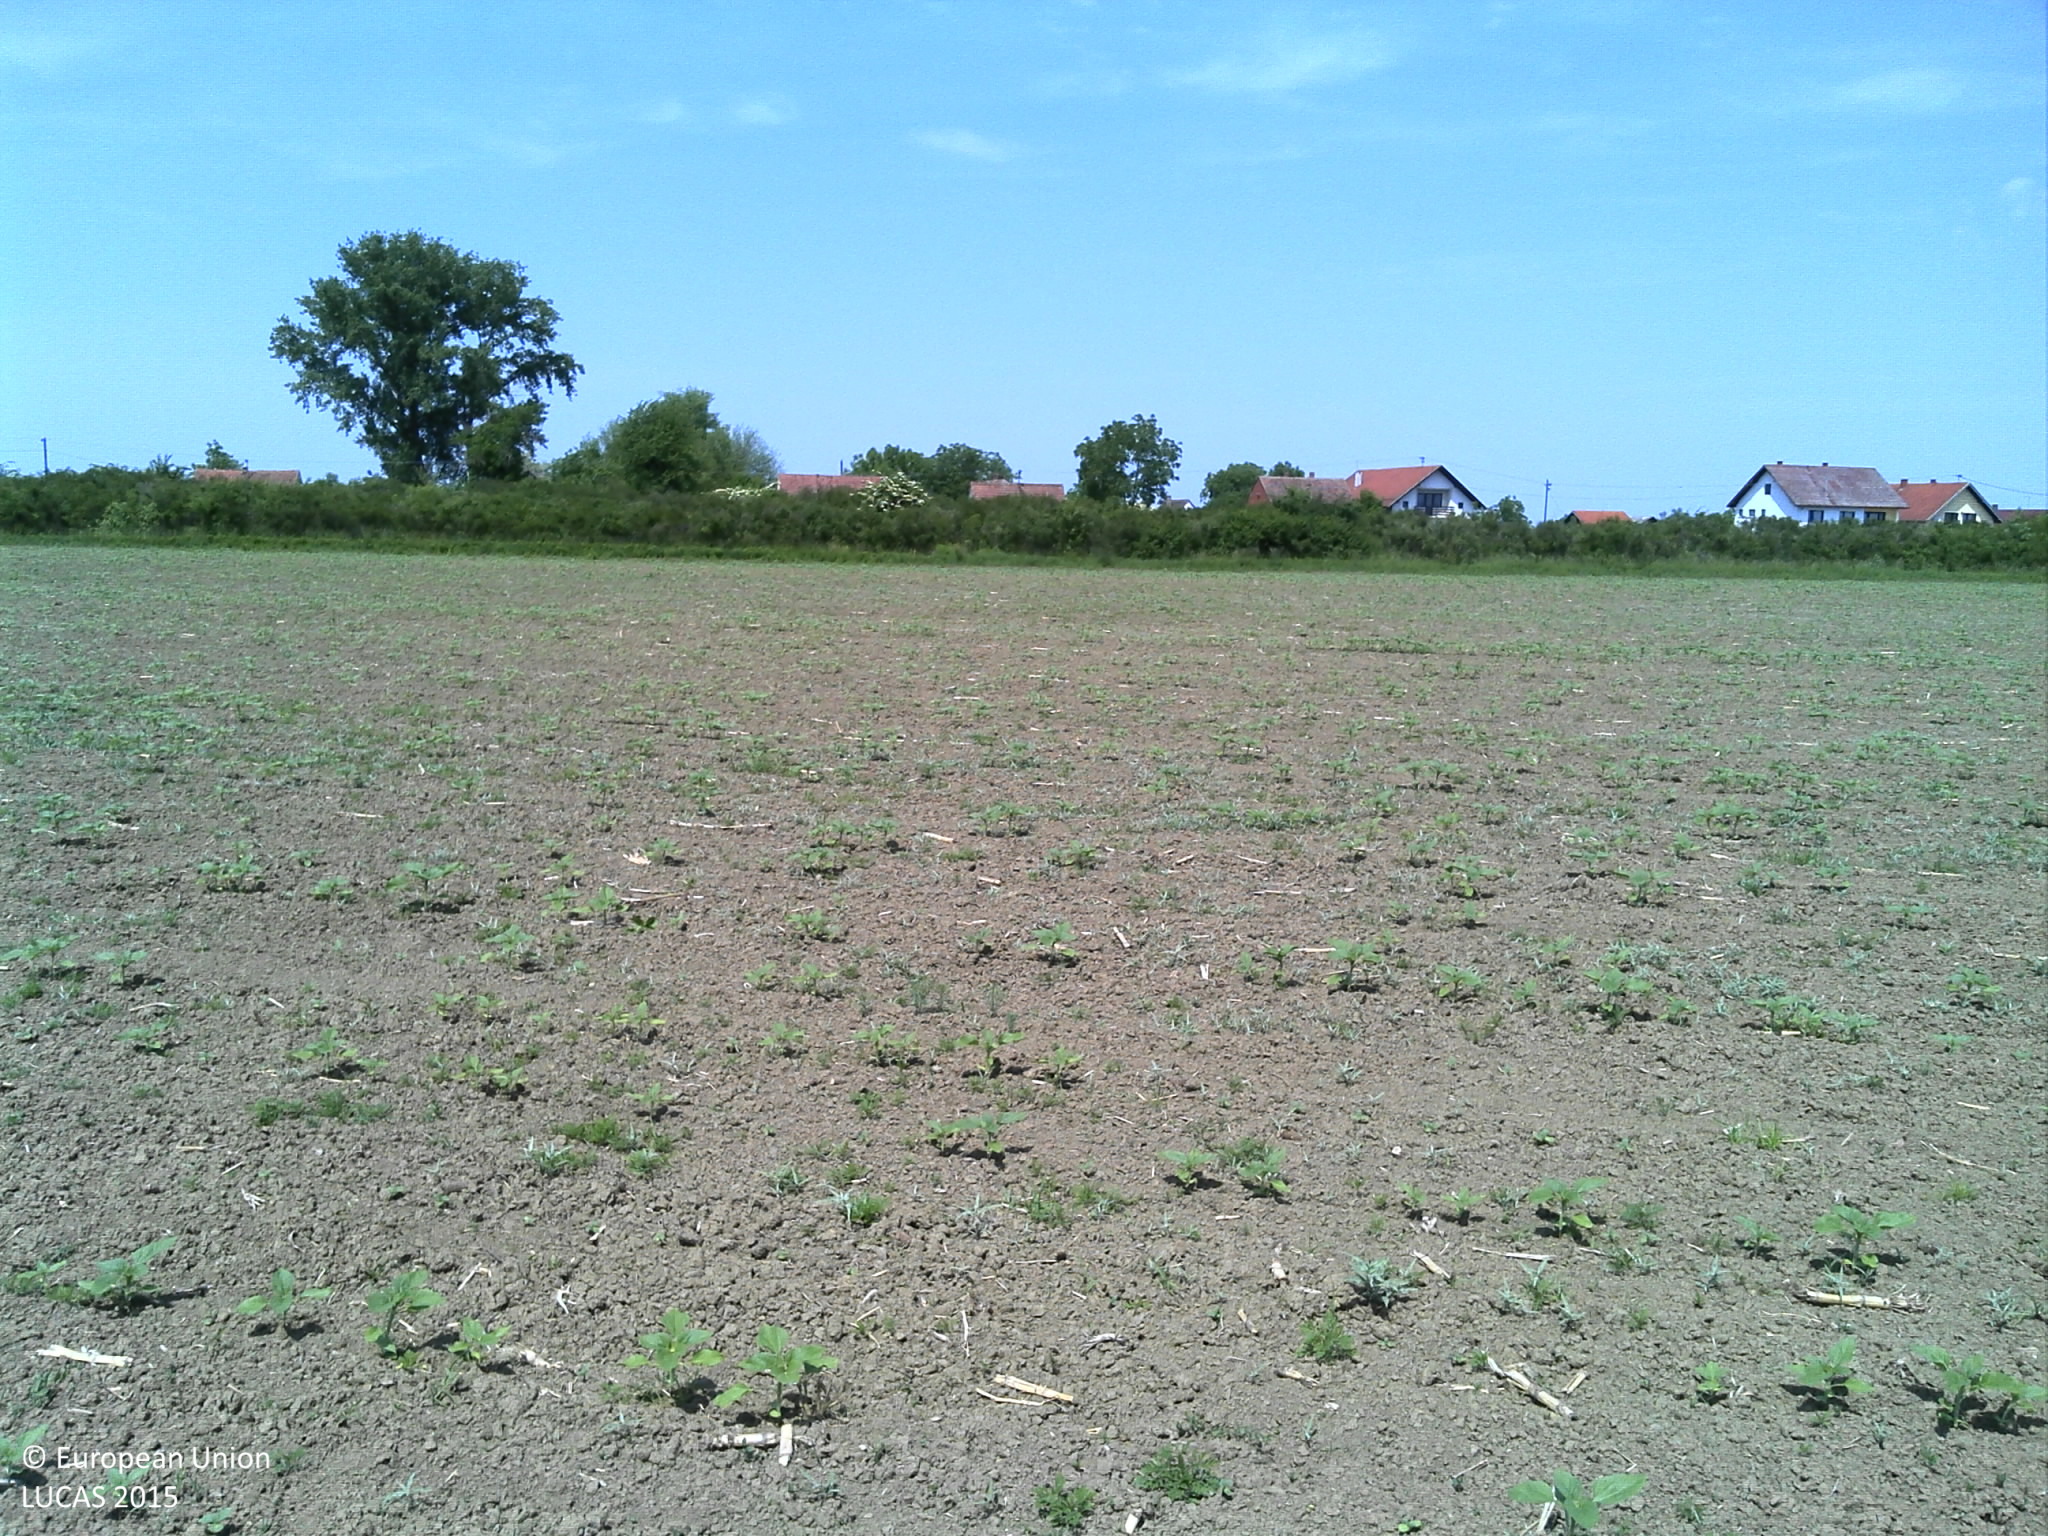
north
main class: Cropland
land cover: Soya
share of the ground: < 10 %
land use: Agriculture (excluding fallow land and kitchen gardens)
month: May
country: HR
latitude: 45.5301
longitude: 18.1868
